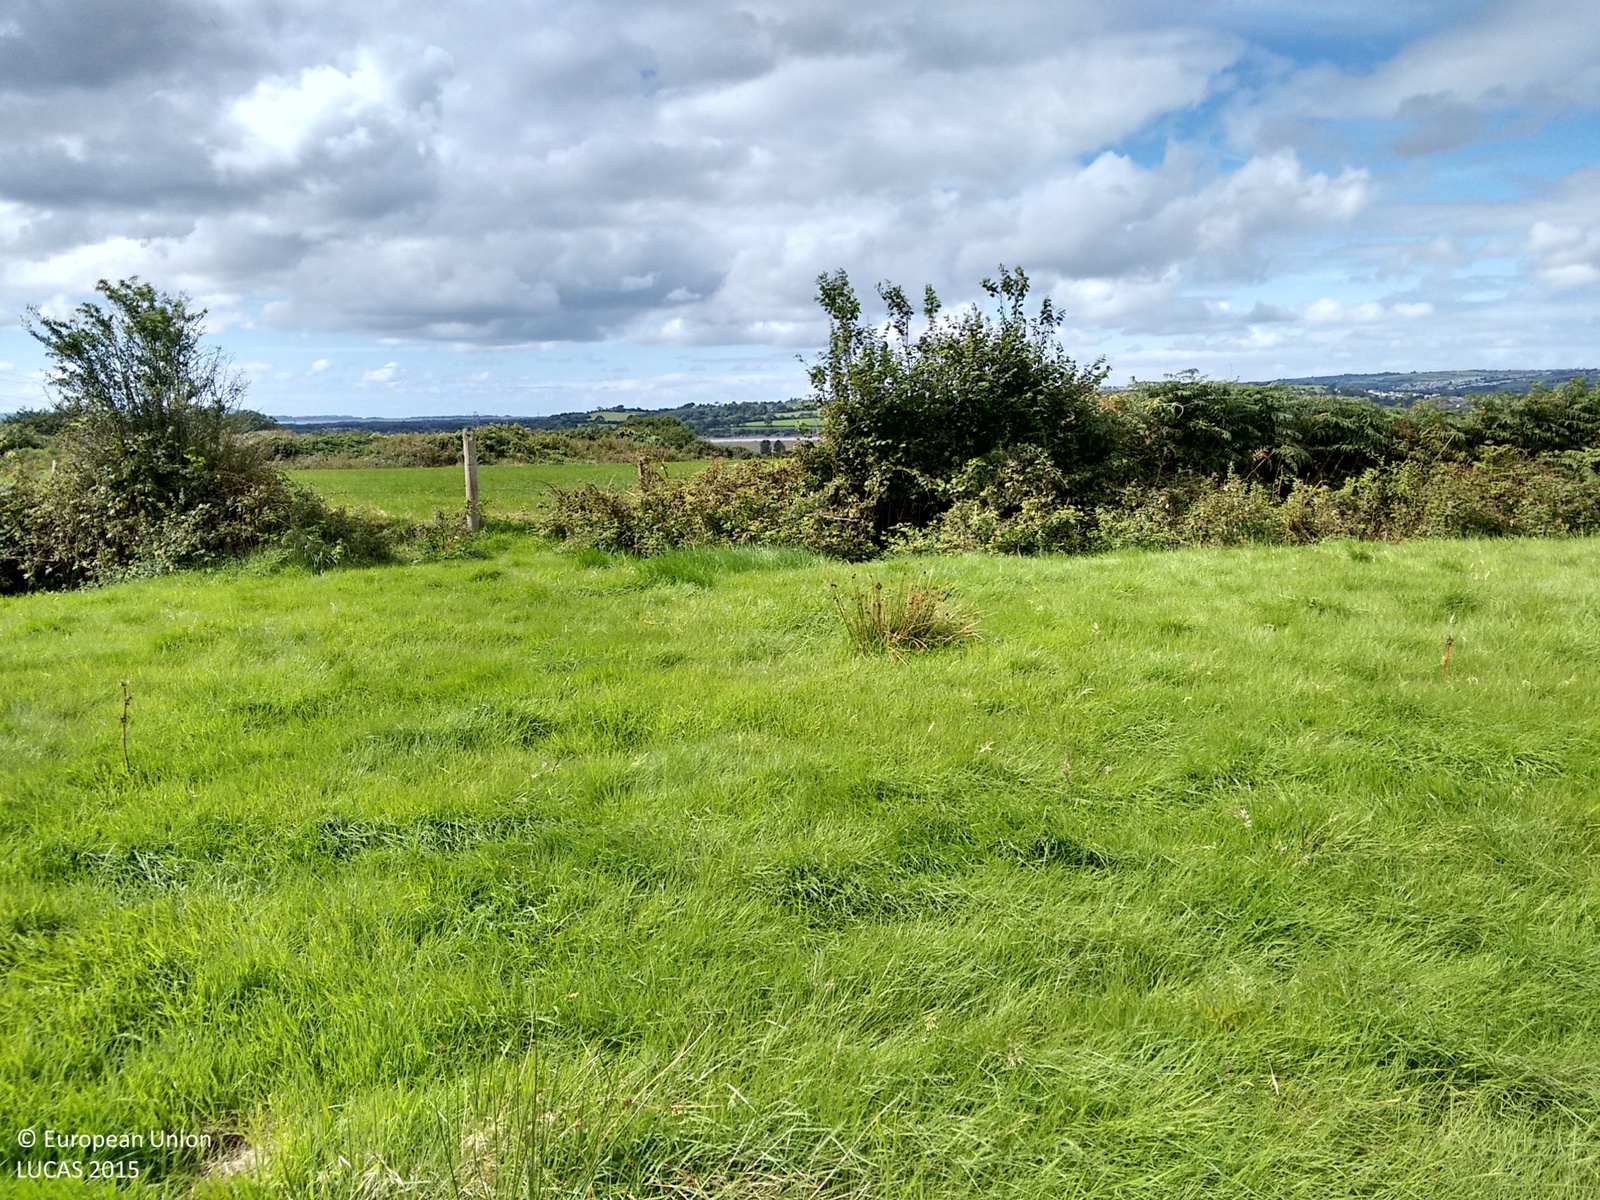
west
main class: Grassland
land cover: Grassland without tree/shrub cover
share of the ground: > 75 %
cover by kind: herbaceous plants 100 %
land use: Agriculture (excluding fallow land and kitchen gardens)
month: September
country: GB
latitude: 51.6820
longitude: -4.0528
